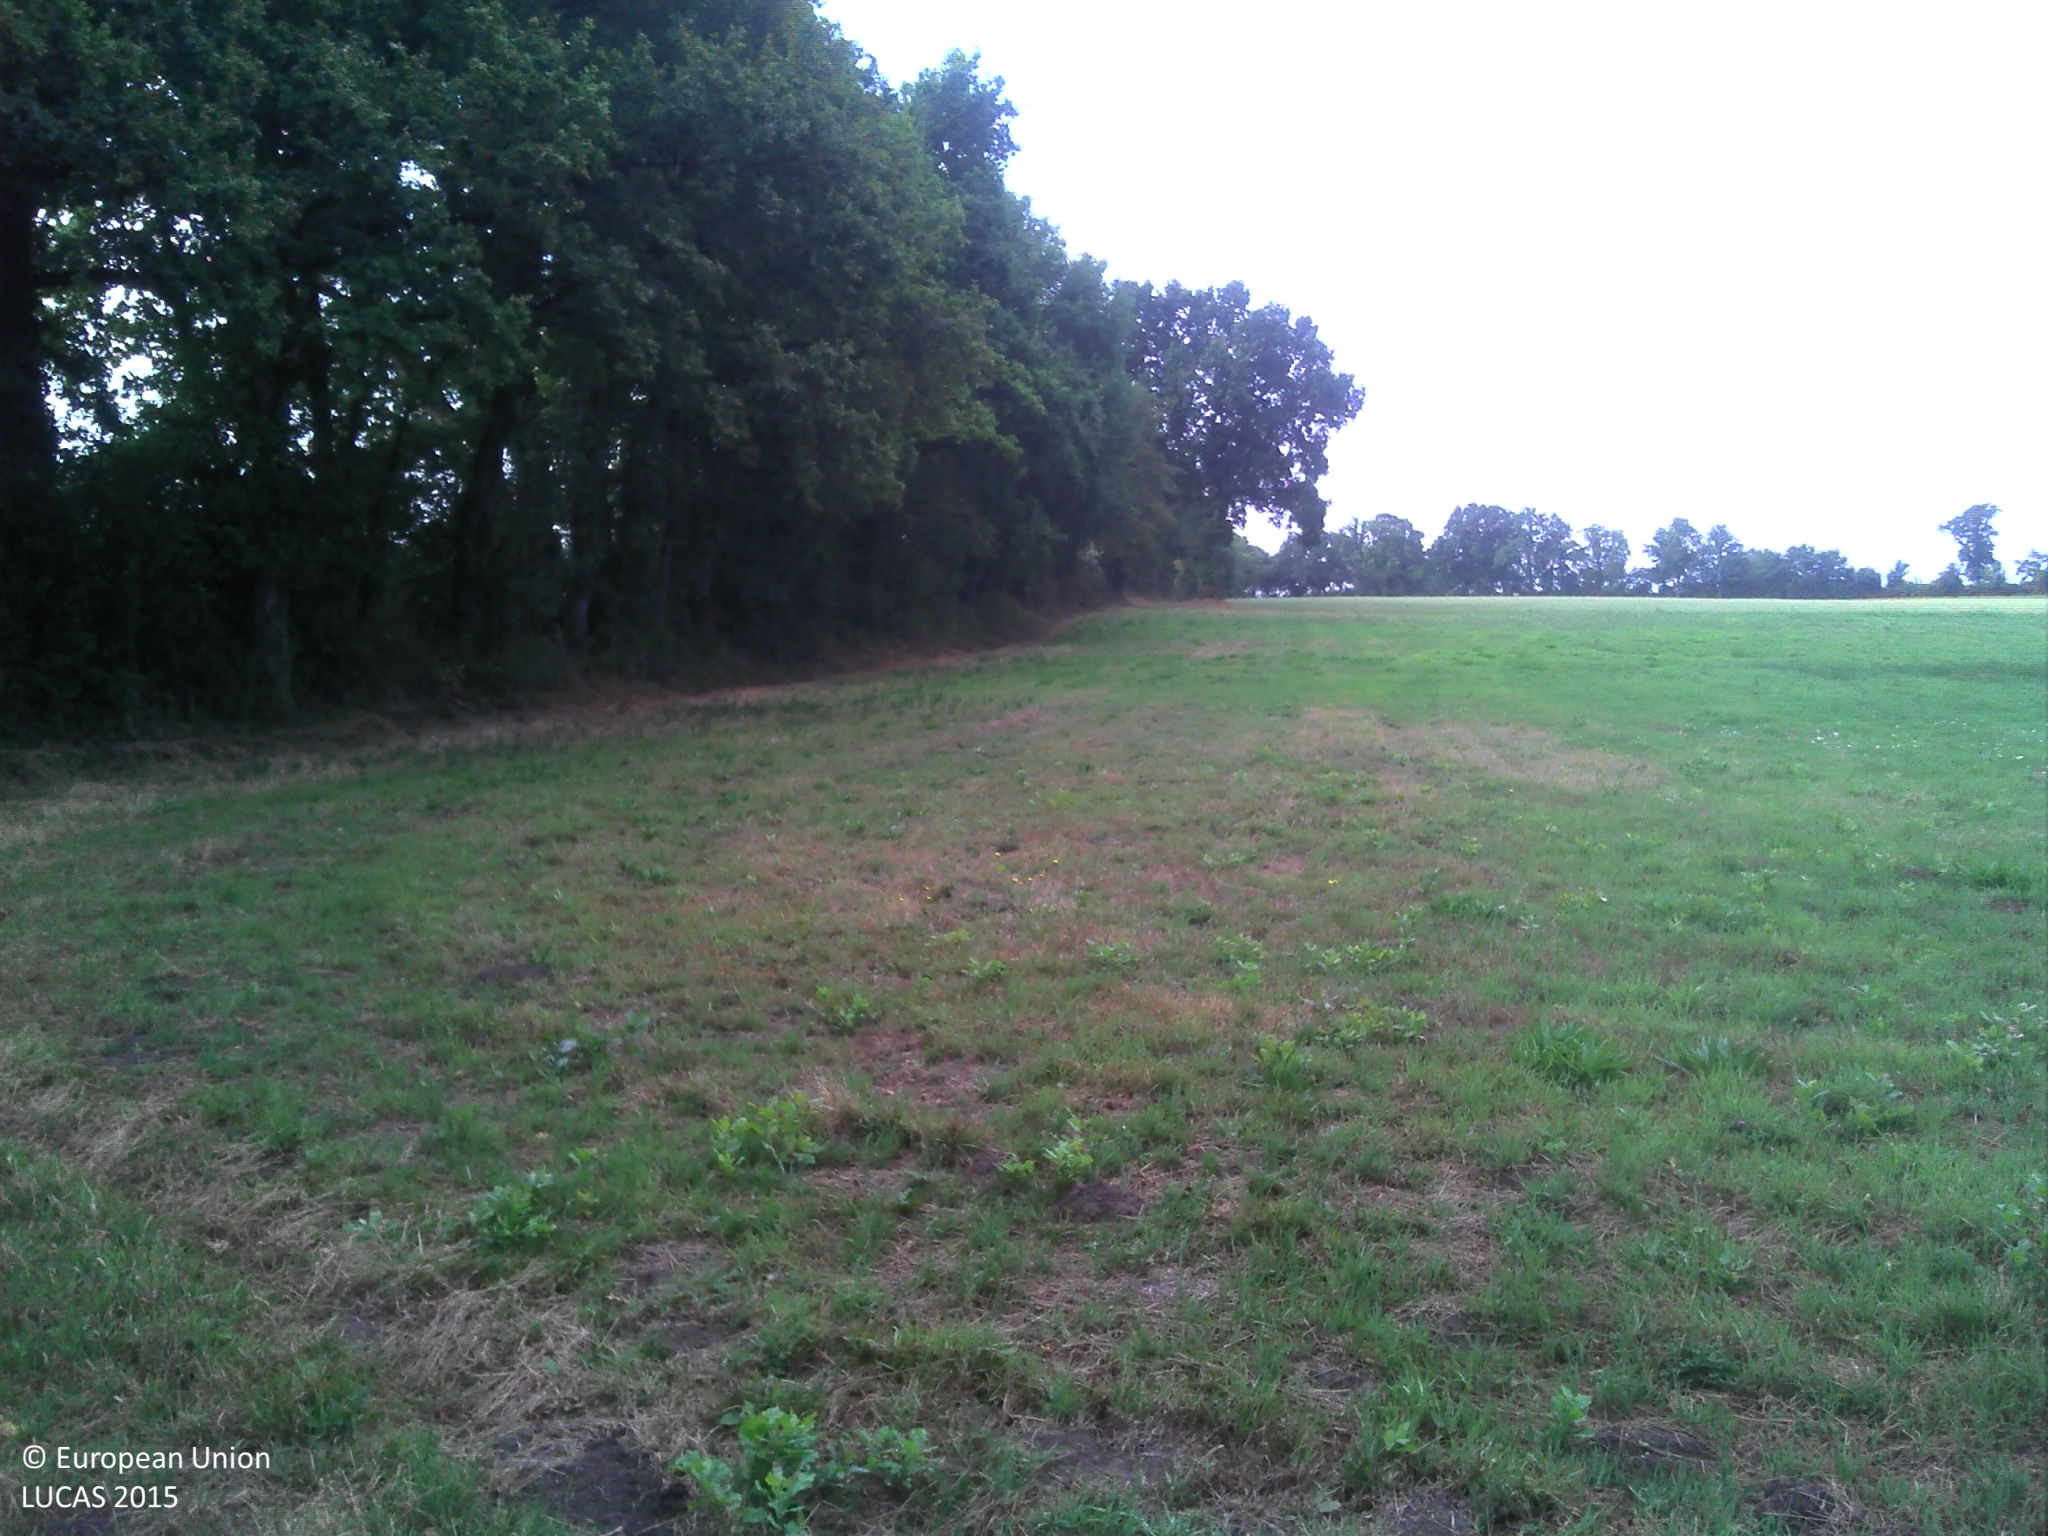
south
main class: Grassland
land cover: Grassland without tree/shrub cover
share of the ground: > 75 %
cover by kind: herbaceous plants 100 %
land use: Agriculture (excluding fallow land and kitchen gardens)
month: August
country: FR
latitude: 46.7104
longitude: -1.6698
